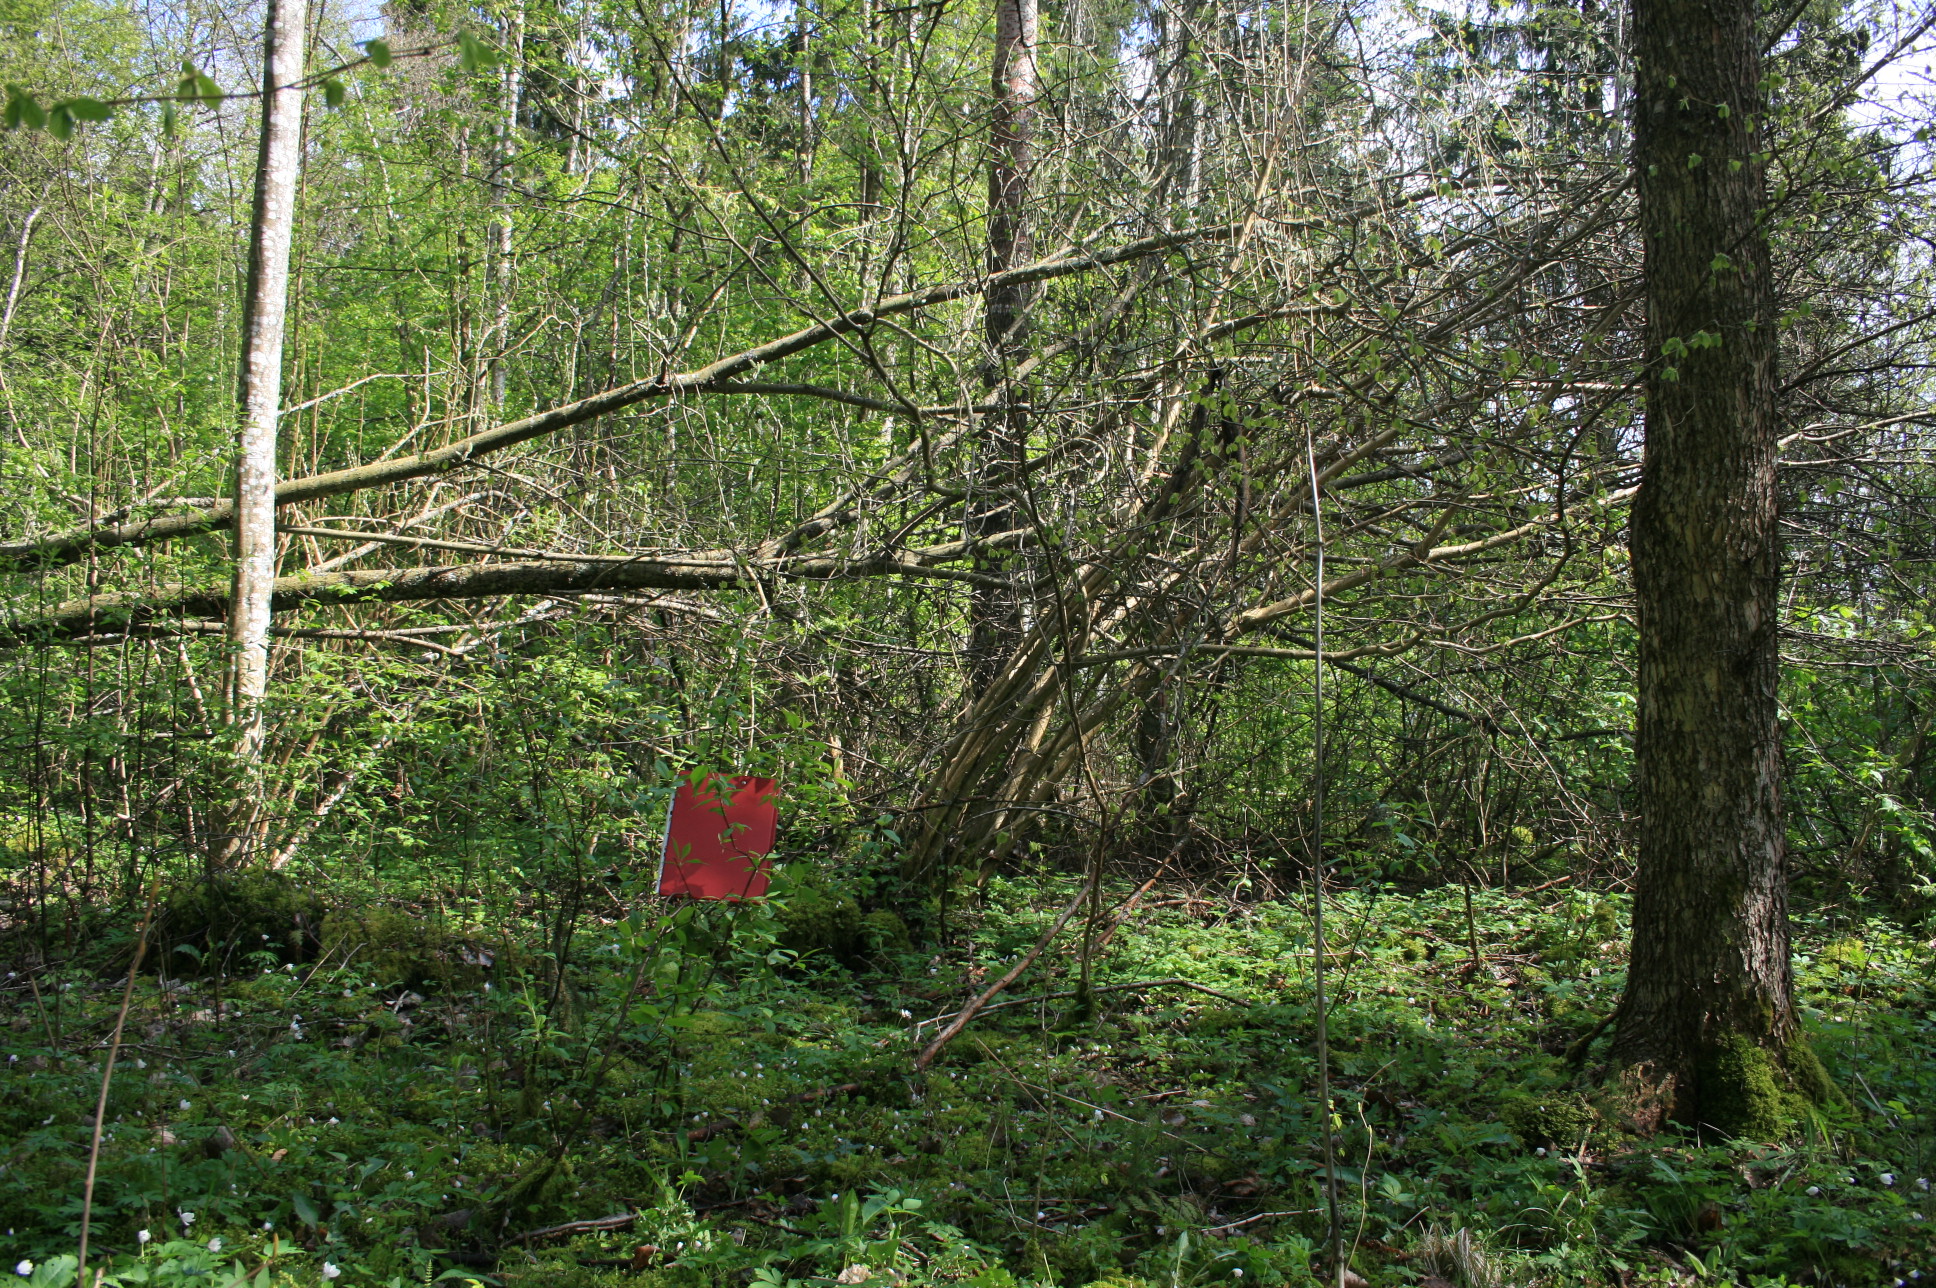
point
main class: Woodland
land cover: Spruce dominated mixed woodland
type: hemiboreal forest and nemoral coniferous forest and mixed broadleaved-coniferous forest
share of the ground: > 75 %
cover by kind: broadleaved forest trees 60 %, coniferous forest trees 40 %
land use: Forestry
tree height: > 5 m
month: May
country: LT
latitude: 56.3258
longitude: 22.0663
